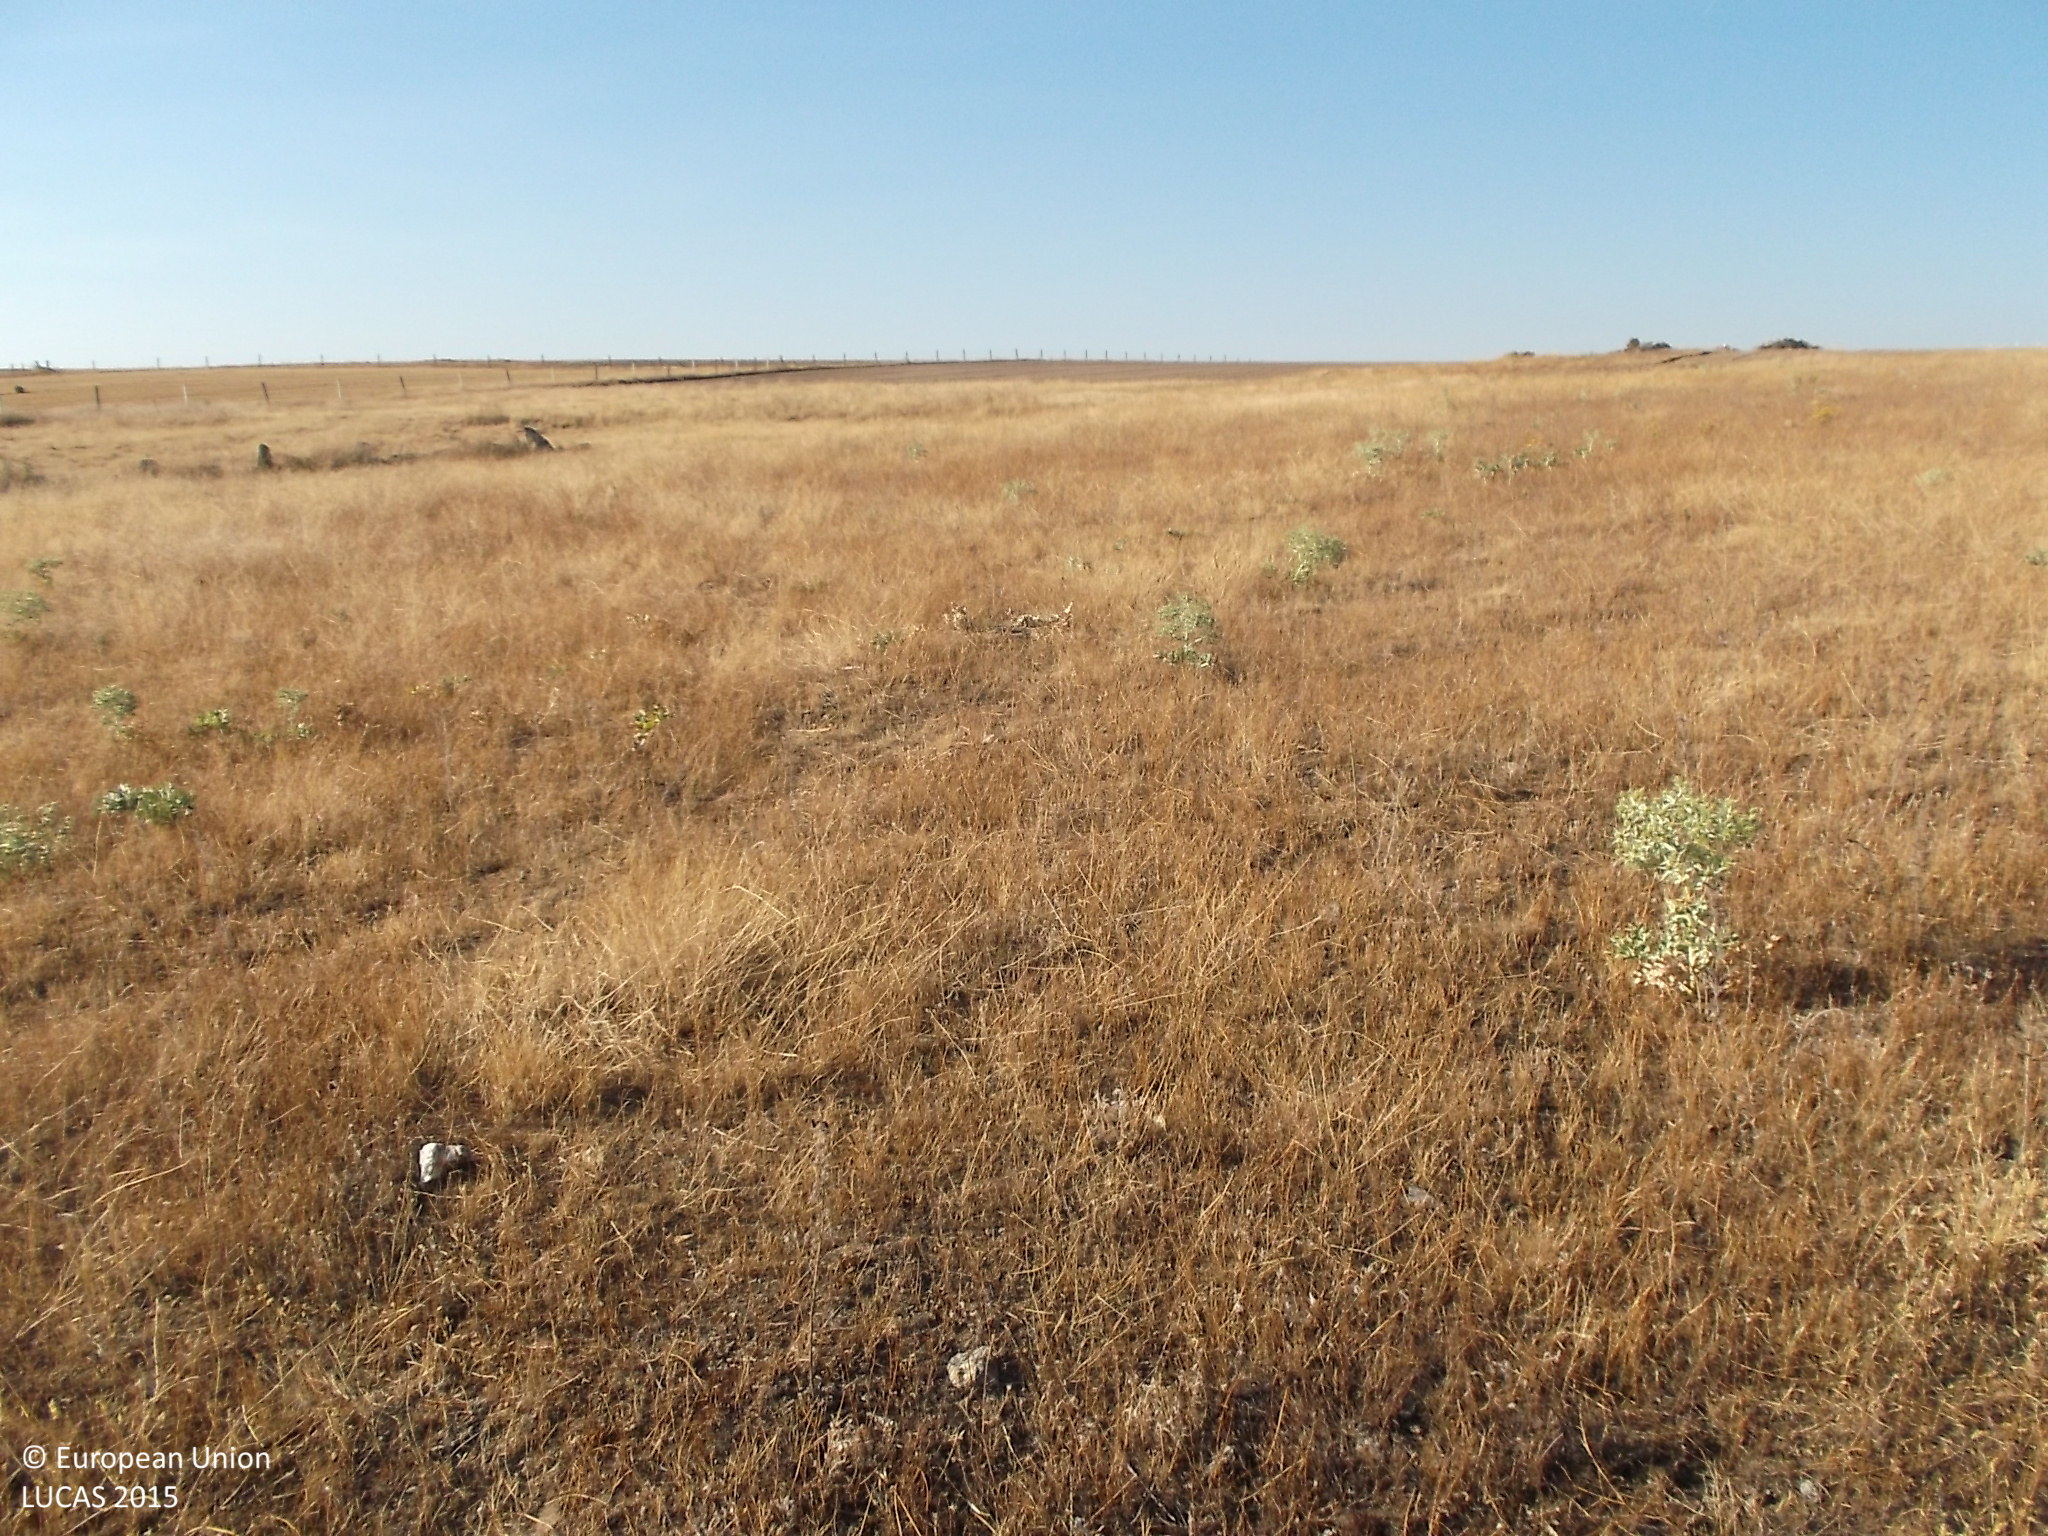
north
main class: Grassland
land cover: Grassland without tree/shrub cover
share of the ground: > 75 %
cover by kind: herbaceous plants 100 %
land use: Agriculture (excluding fallow land and kitchen gardens)
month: July
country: ES
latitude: 41.1428
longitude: -5.9433
